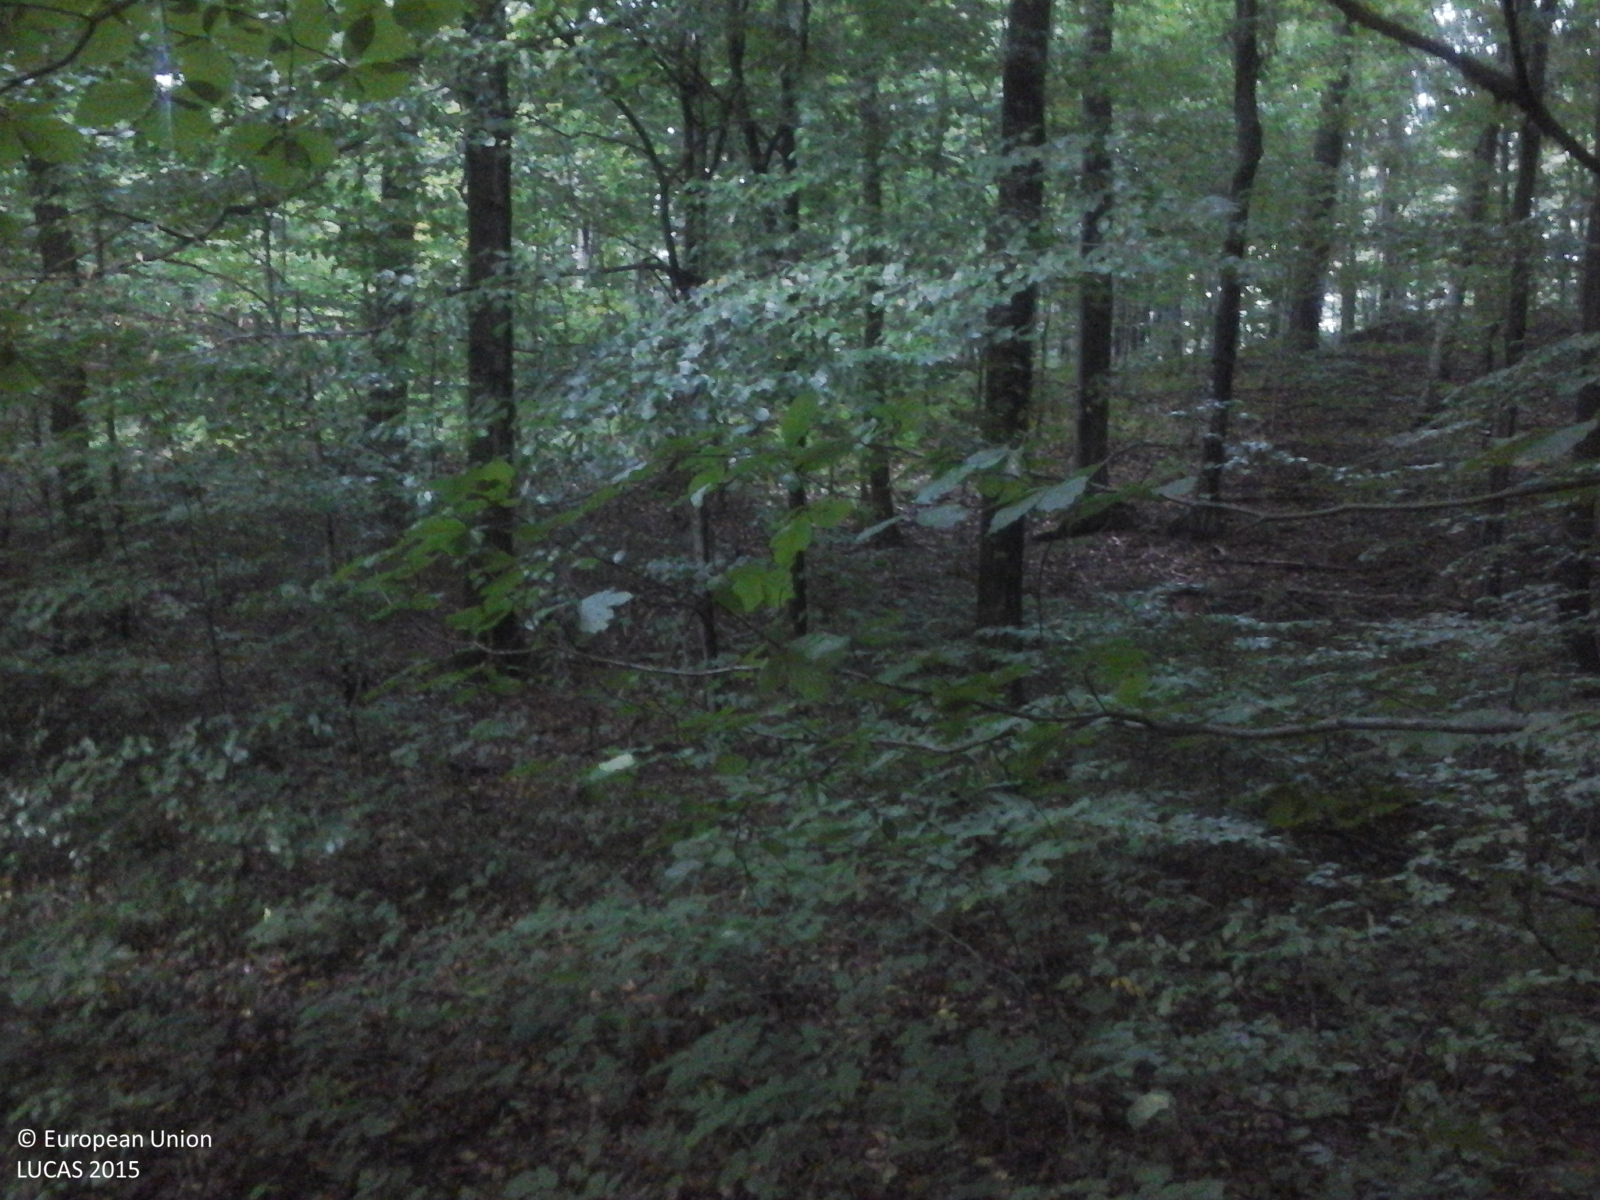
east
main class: Woodland
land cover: Broadleaved woodland
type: beech forest
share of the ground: > 75 %
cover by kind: broadleaved forest trees 100 %
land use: Forestry
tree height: > 5 m
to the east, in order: Broadleaved woodland
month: August
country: RO
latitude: 44.7857
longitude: 21.7981
